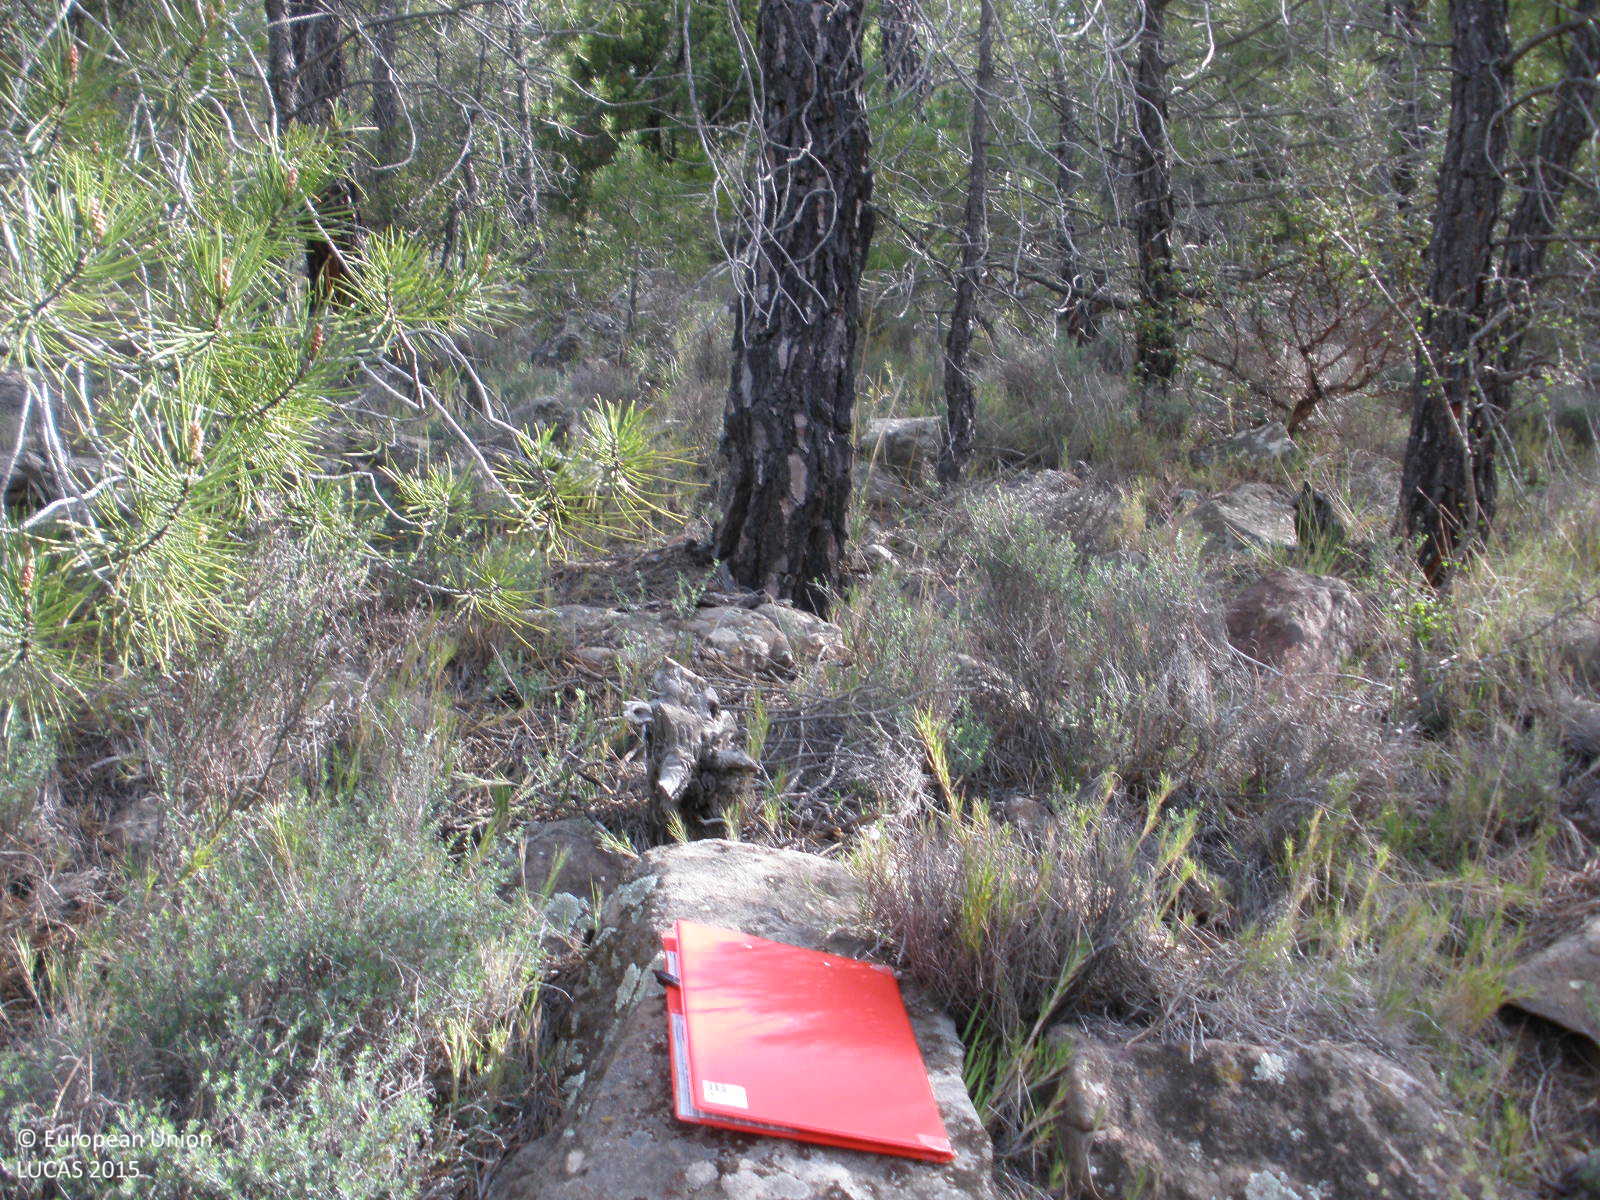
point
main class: Woodland
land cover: Pine dominated coniferous woodland
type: coniferous forest of the mediterranean region
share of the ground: > 75 %
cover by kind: coniferous forest trees 75 %, shrubs 20 %, consolidated bare surface 5 %
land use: Semi-natural and natural areas not in use
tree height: > 5 m
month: April
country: ES
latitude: 40.3616
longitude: -0.8070
